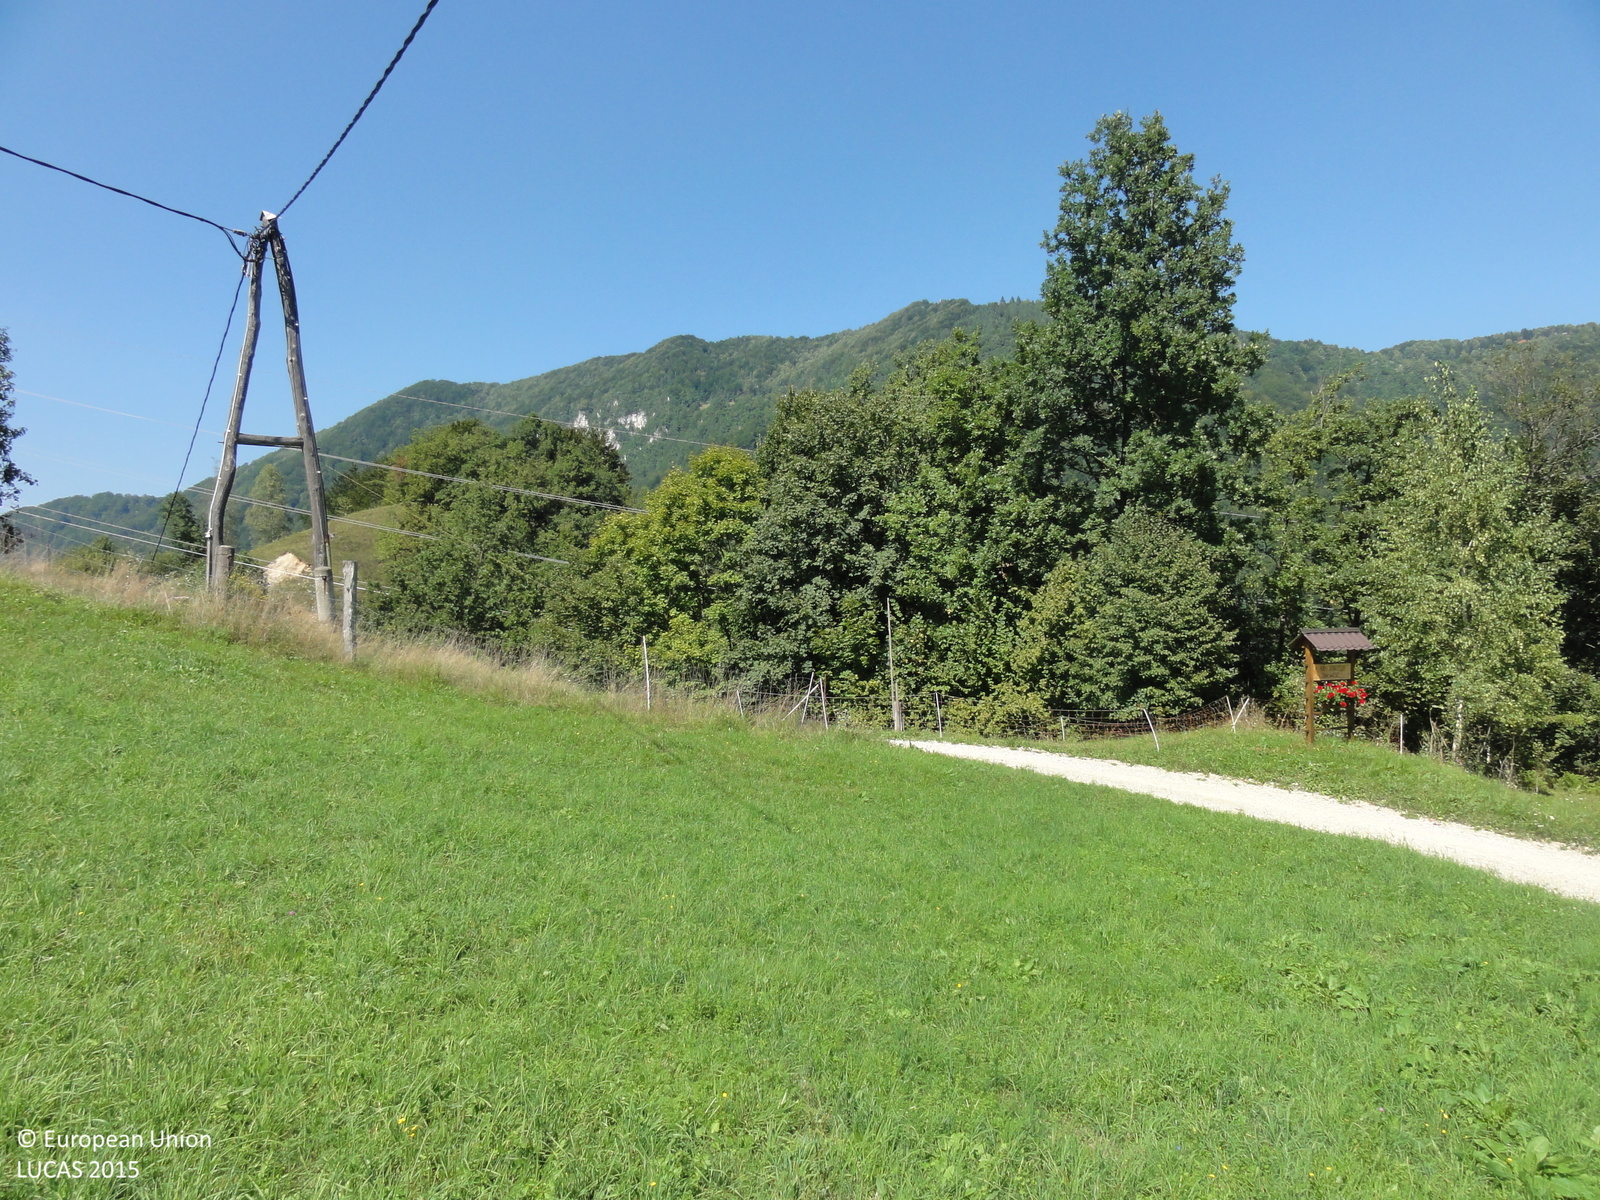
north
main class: Grassland
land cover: Grassland without tree/shrub cover
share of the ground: > 75 %
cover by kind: herbaceous plants 100 %
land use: Agriculture (excluding fallow land and kitchen gardens)
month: August
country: SI
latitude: 46.1017
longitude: 15.1328
